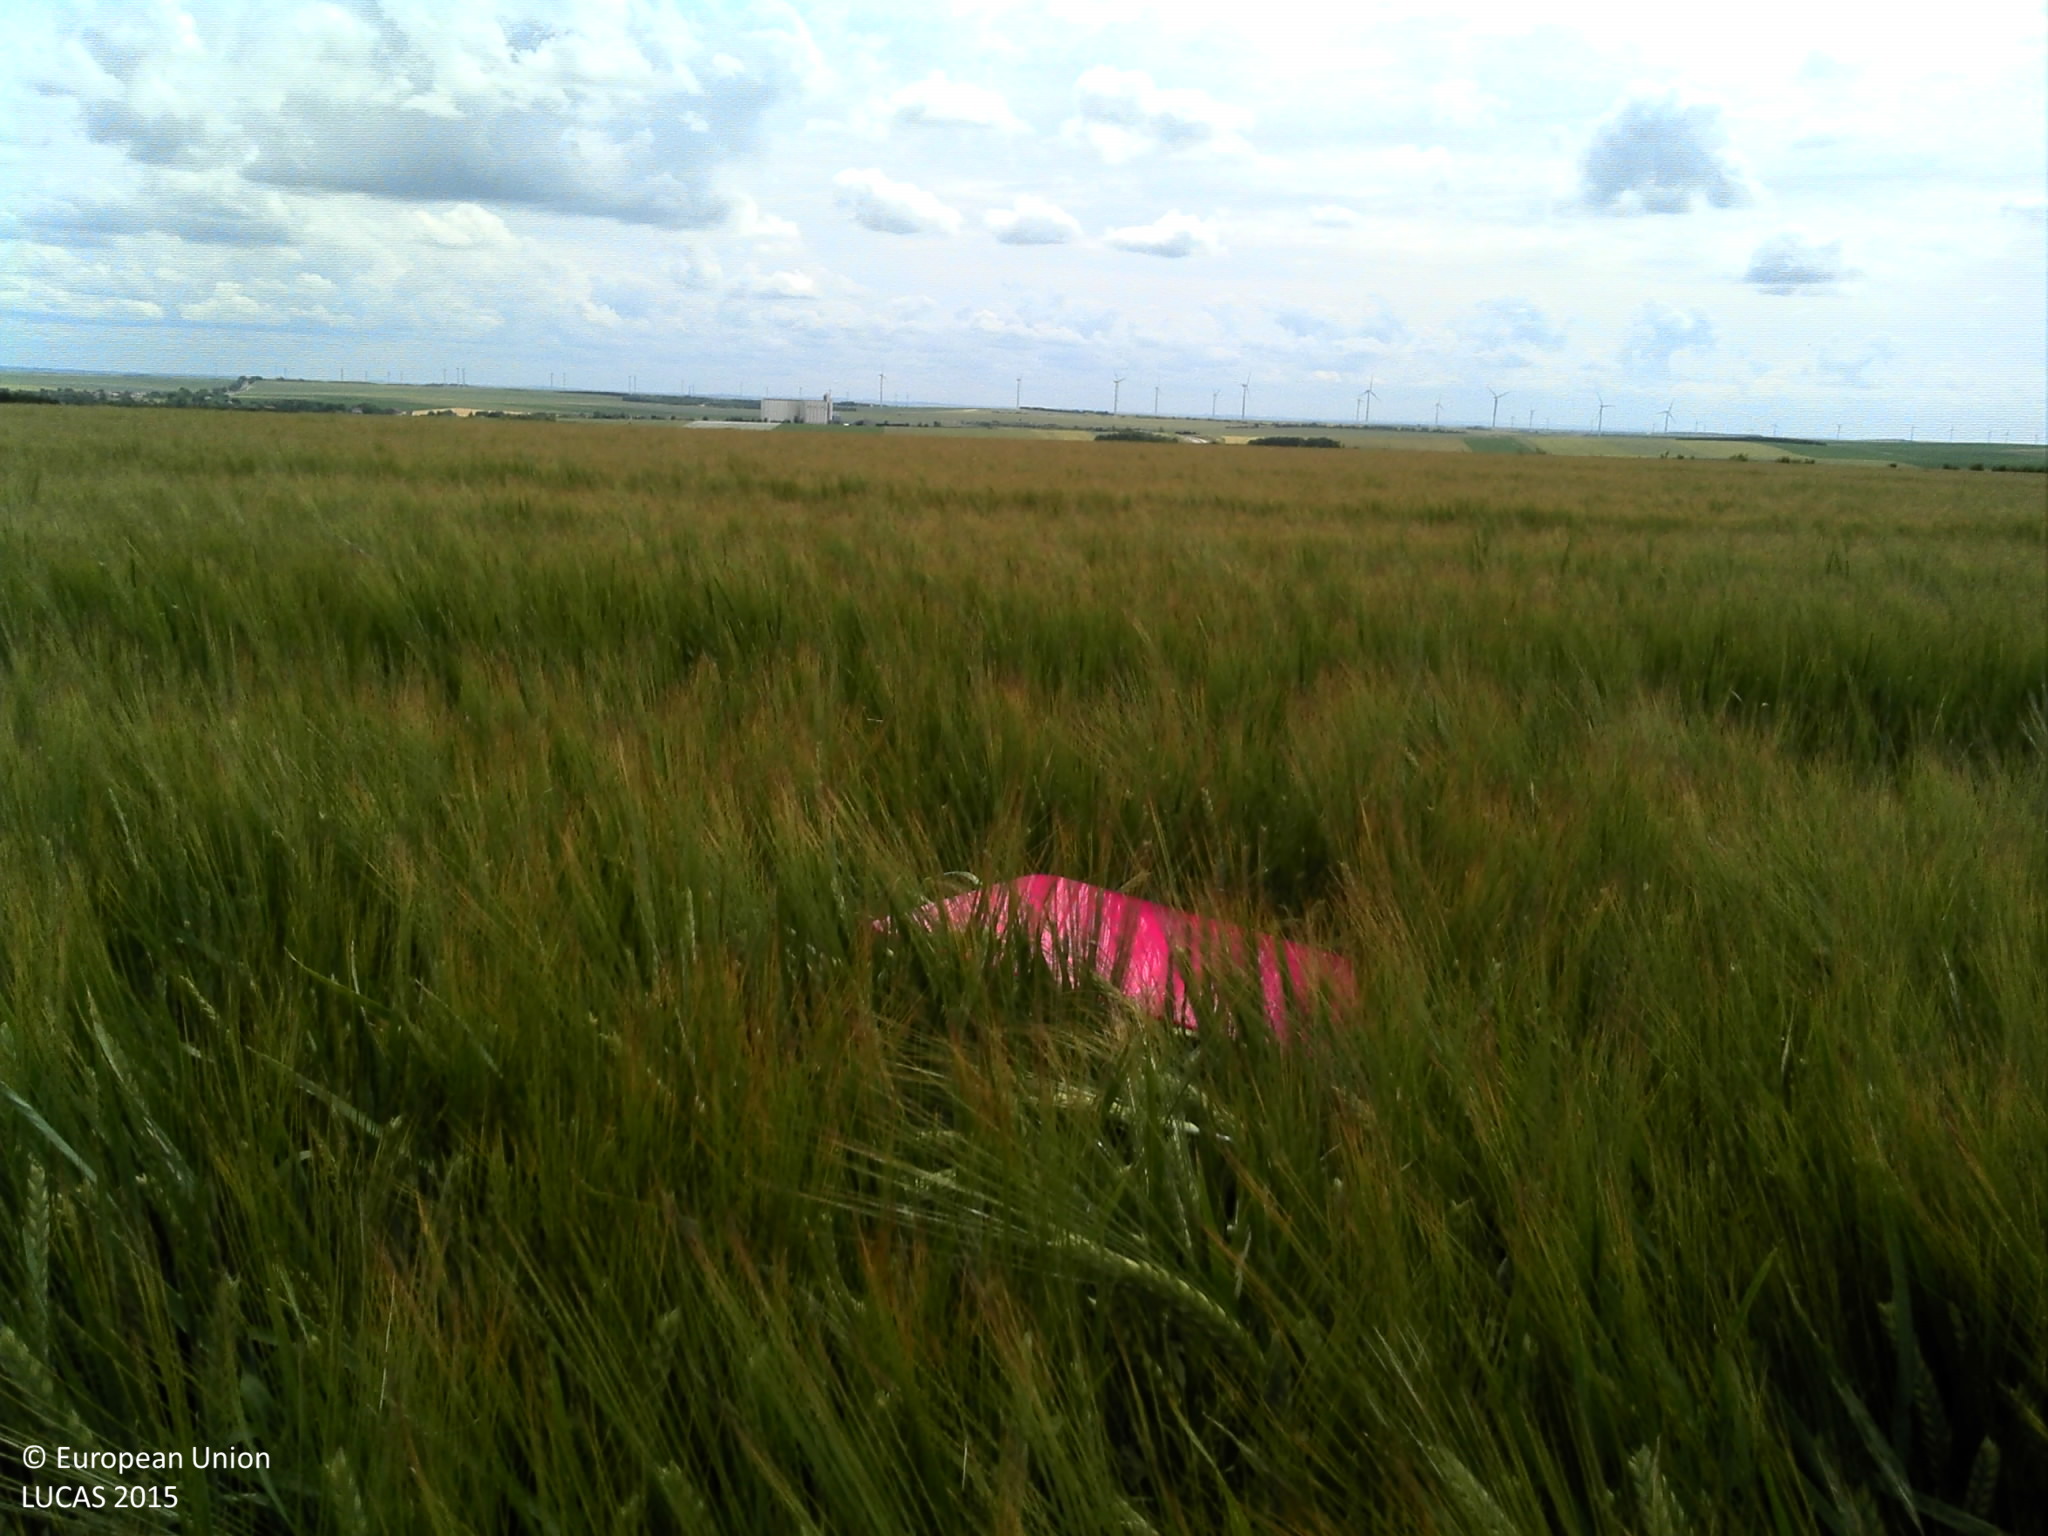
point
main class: Cropland
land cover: Barley
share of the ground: > 75 %
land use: Agriculture (excluding fallow land and kitchen gardens)
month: June
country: FR
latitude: 48.7019
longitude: 4.1941
